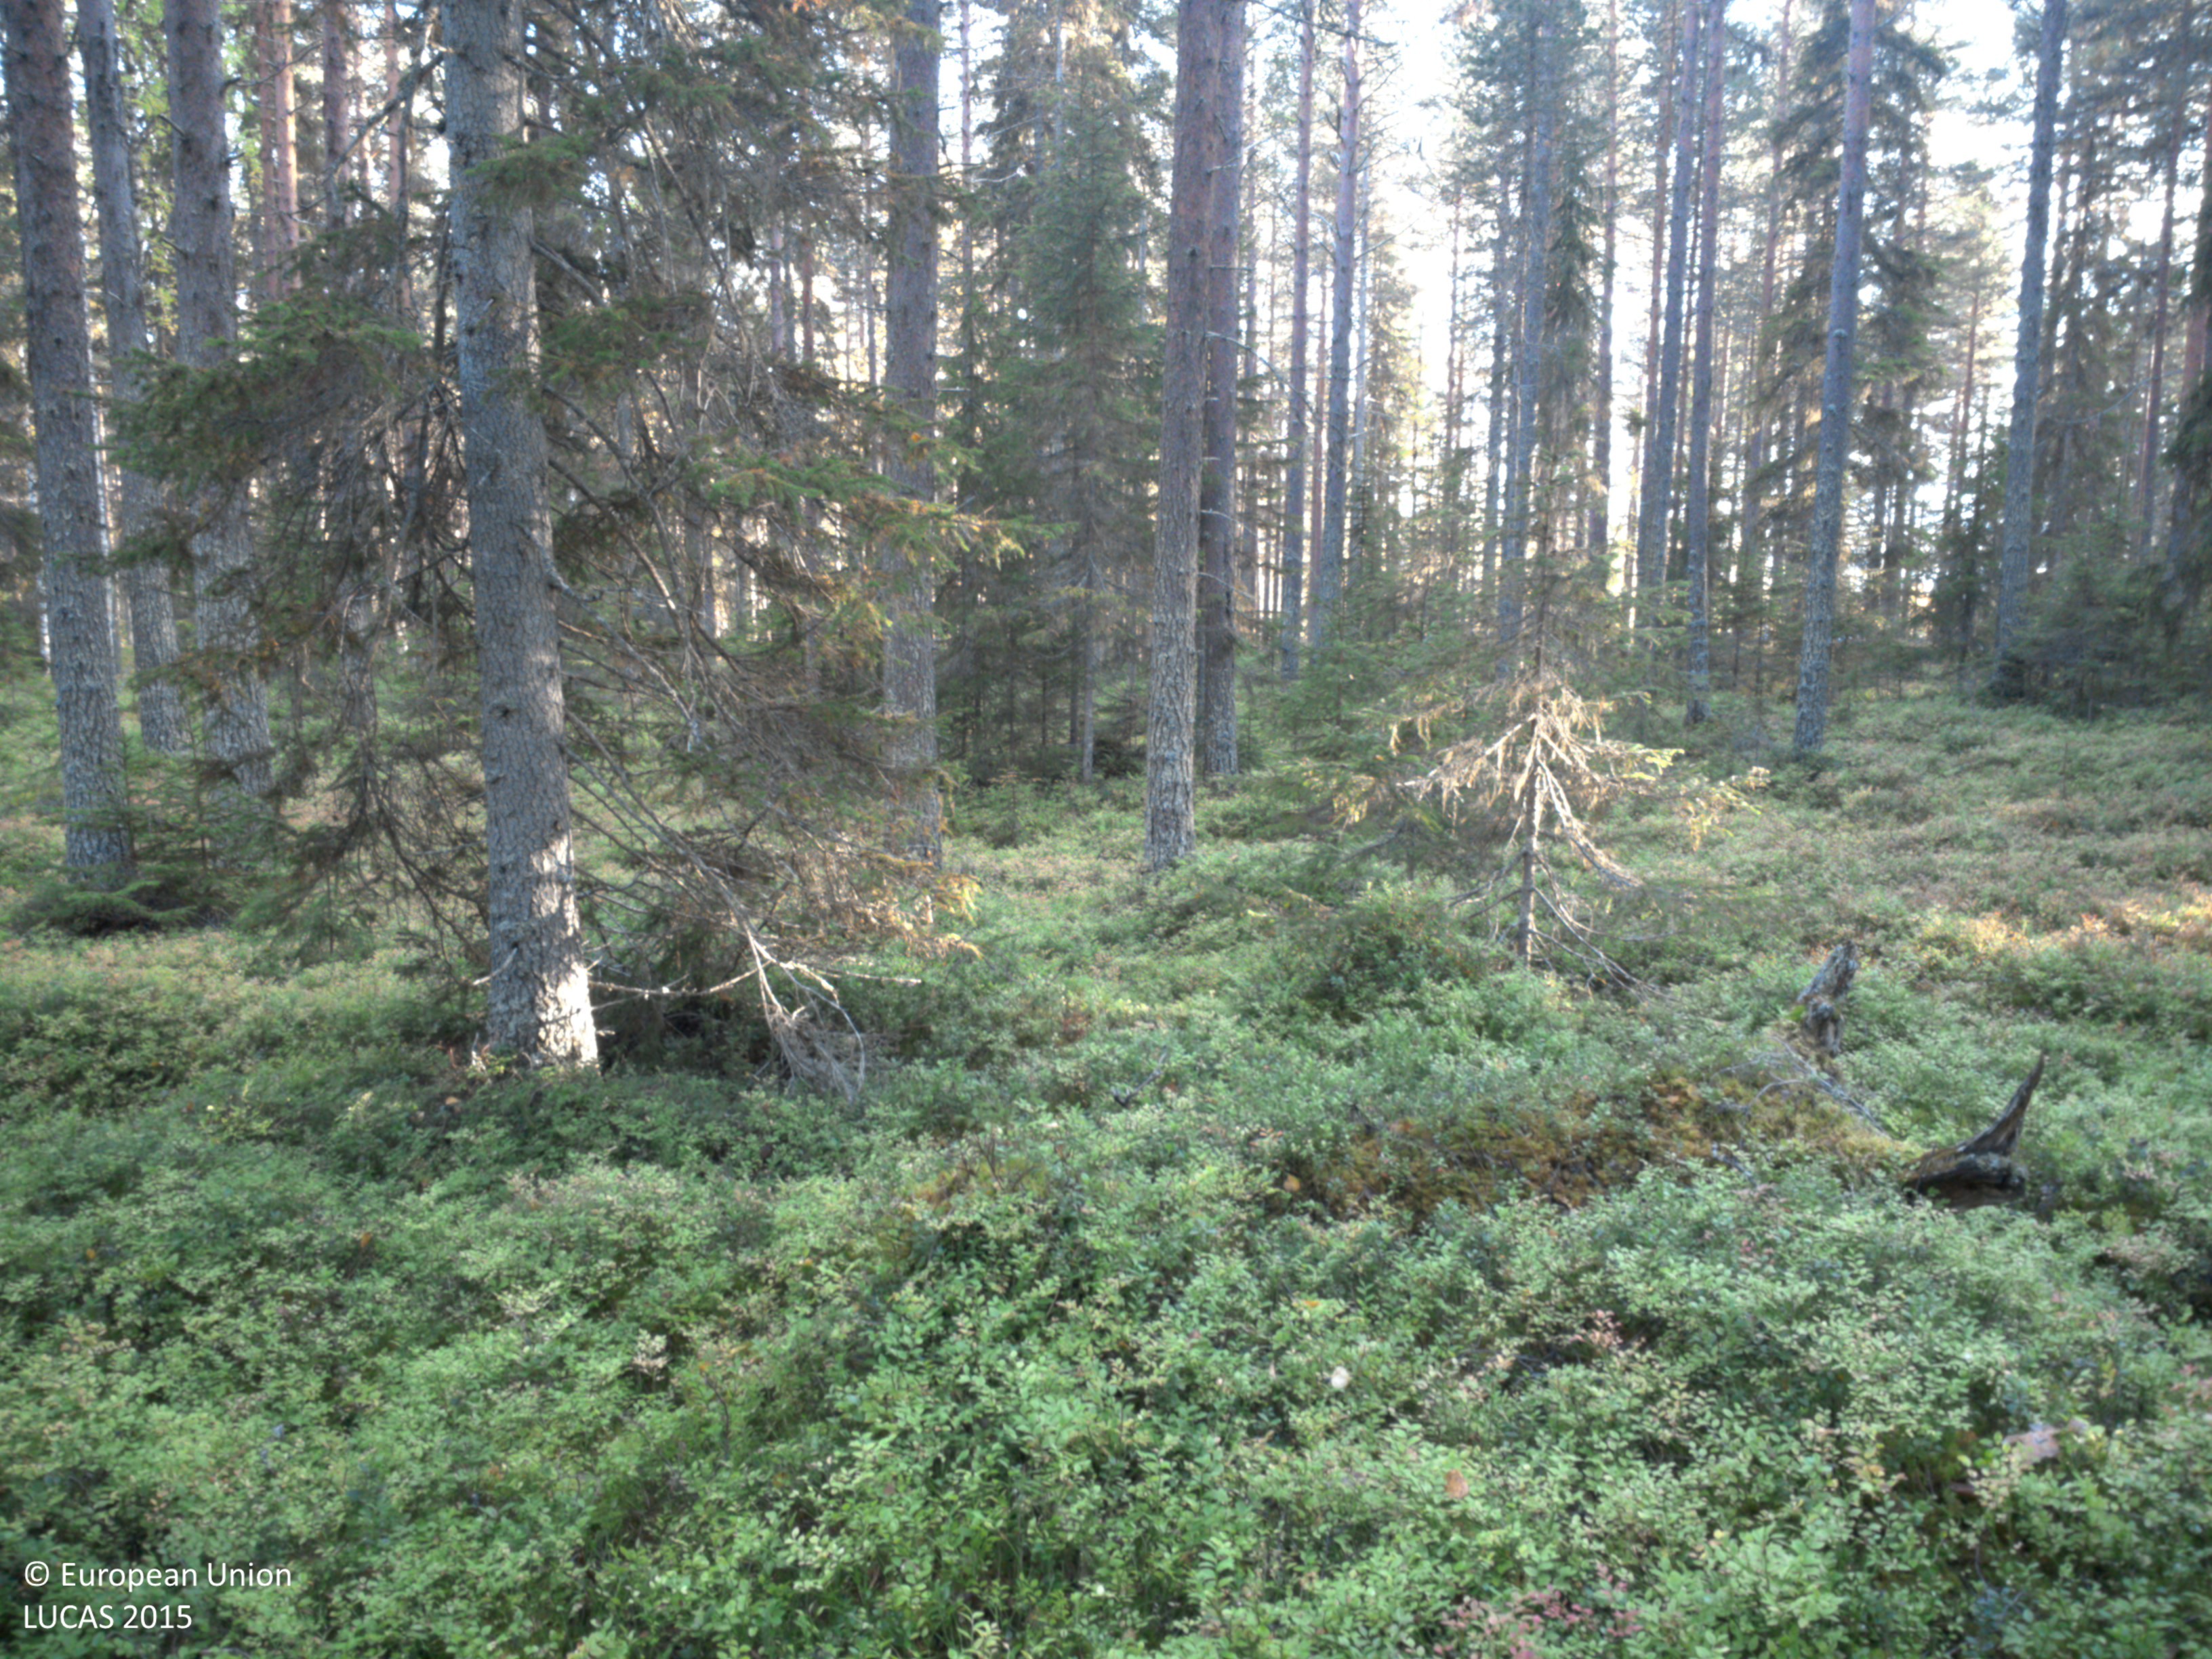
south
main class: Woodland
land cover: Other coniferous woodland
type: boreal forest
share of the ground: > 75 %
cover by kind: coniferous forest trees 70 %, shrubs 25 %, broadleaved forest trees 5 %
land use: Forestry
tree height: > 5 m
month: September
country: SE
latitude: 64.8109
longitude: 19.0854
